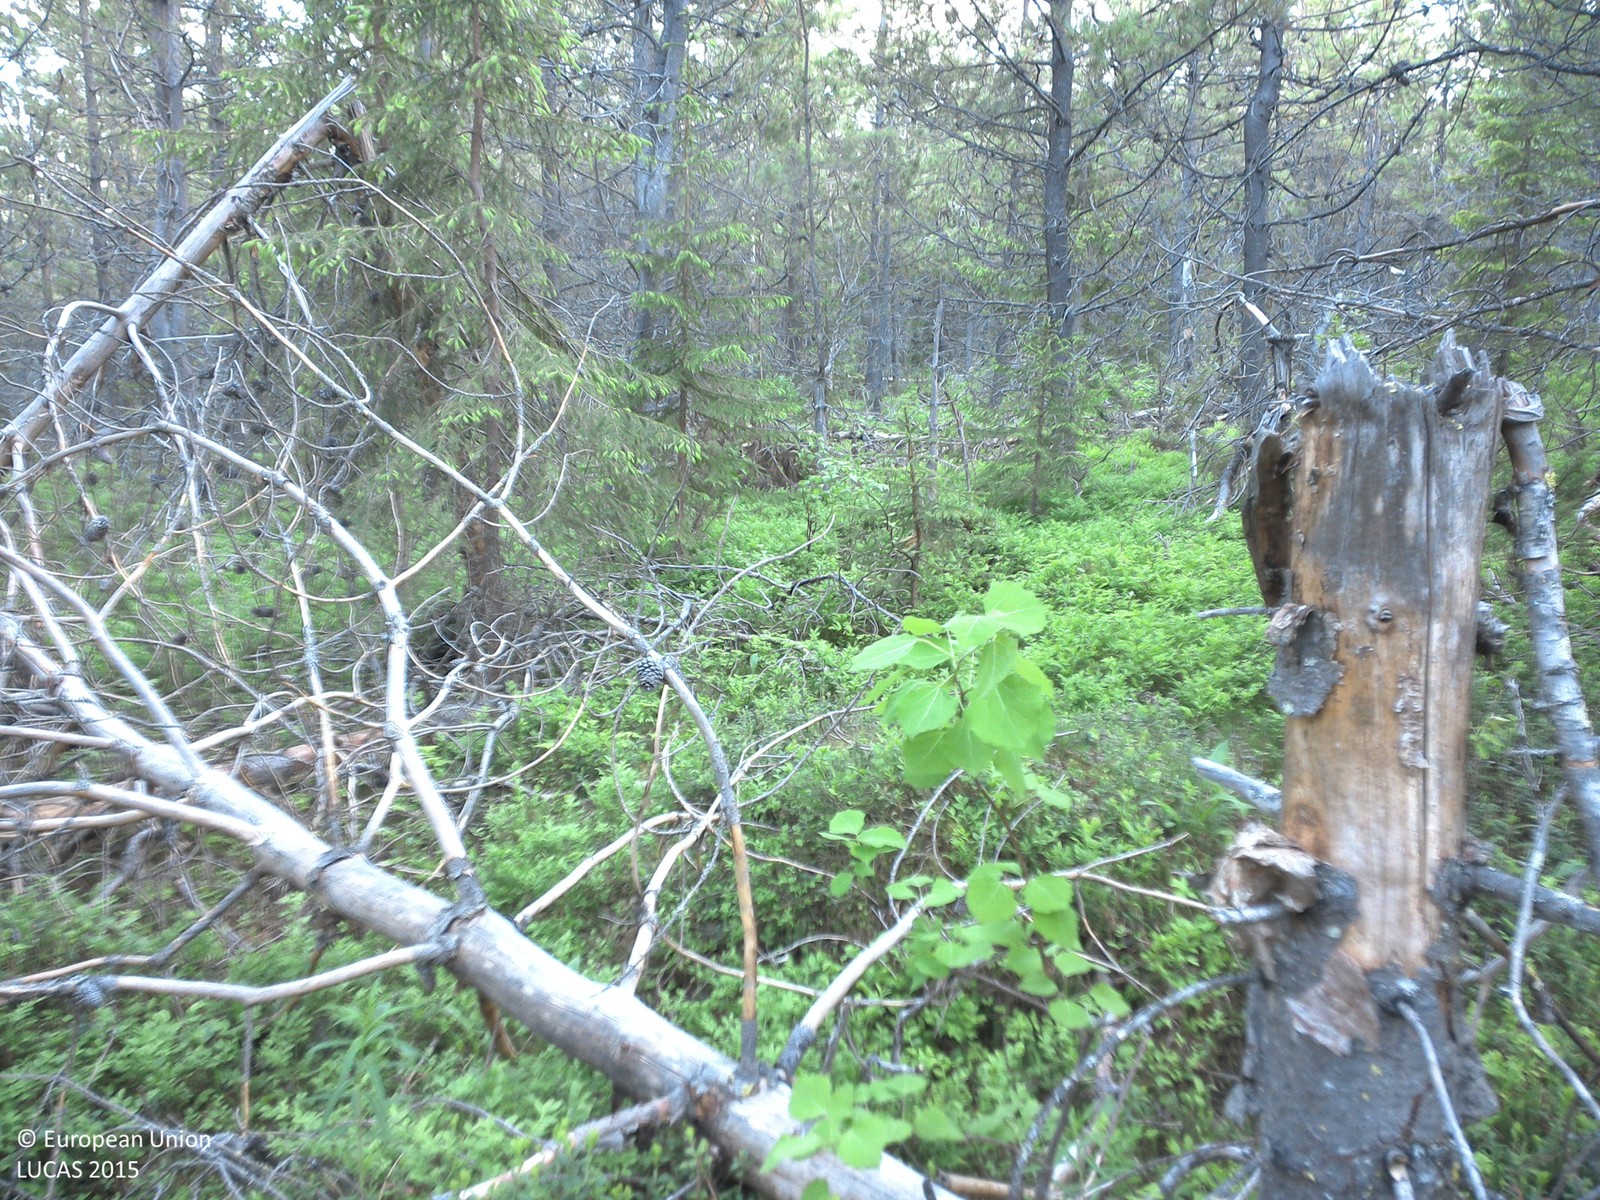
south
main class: Woodland
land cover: Pine dominated coniferous woodland
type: exotic forest
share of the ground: 25 - 50 %
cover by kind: shrubs 60 %, coniferous forest trees 40 %
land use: Forestry
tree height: > 5 m
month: June
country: SE
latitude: 66.5997
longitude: 22.9956
